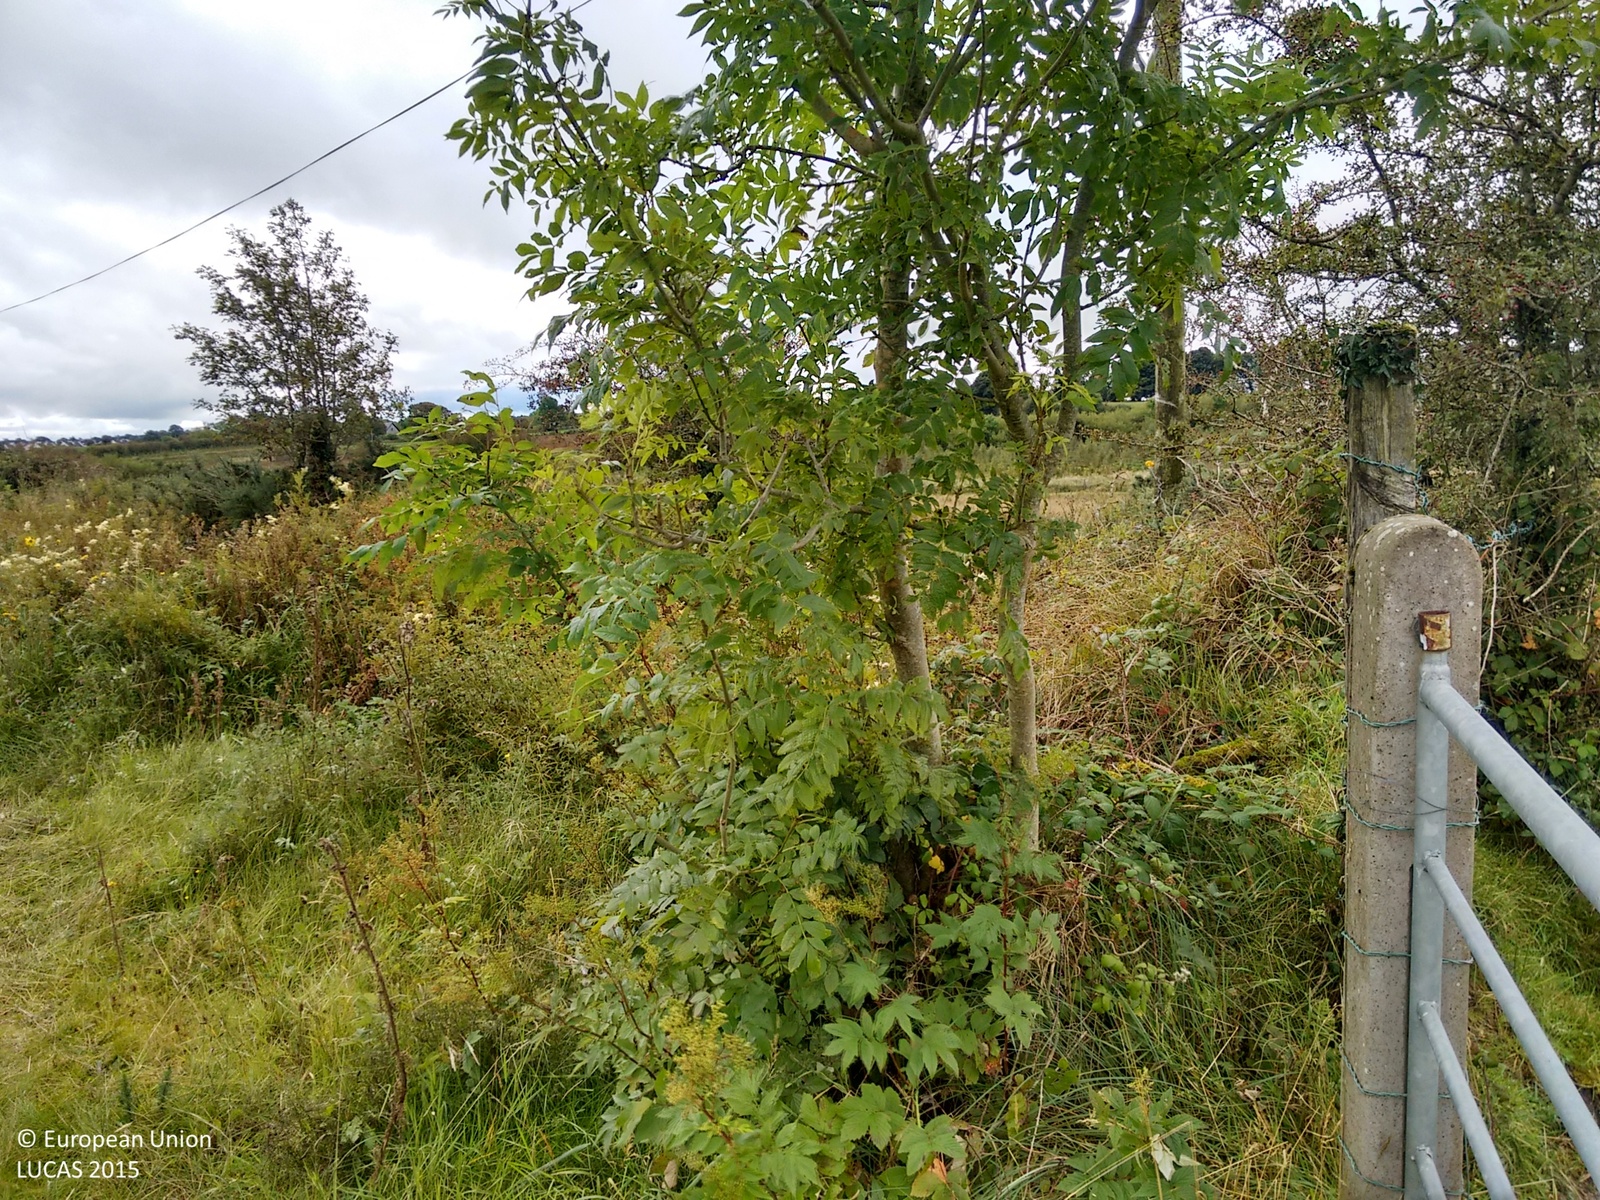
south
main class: Grassland
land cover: Grassland without tree/shrub cover
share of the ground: > 75 %
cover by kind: herbaceous plants 100 %
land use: Agriculture (excluding fallow land and kitchen gardens)
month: September
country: IE
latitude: 53.8120
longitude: -8.9353
